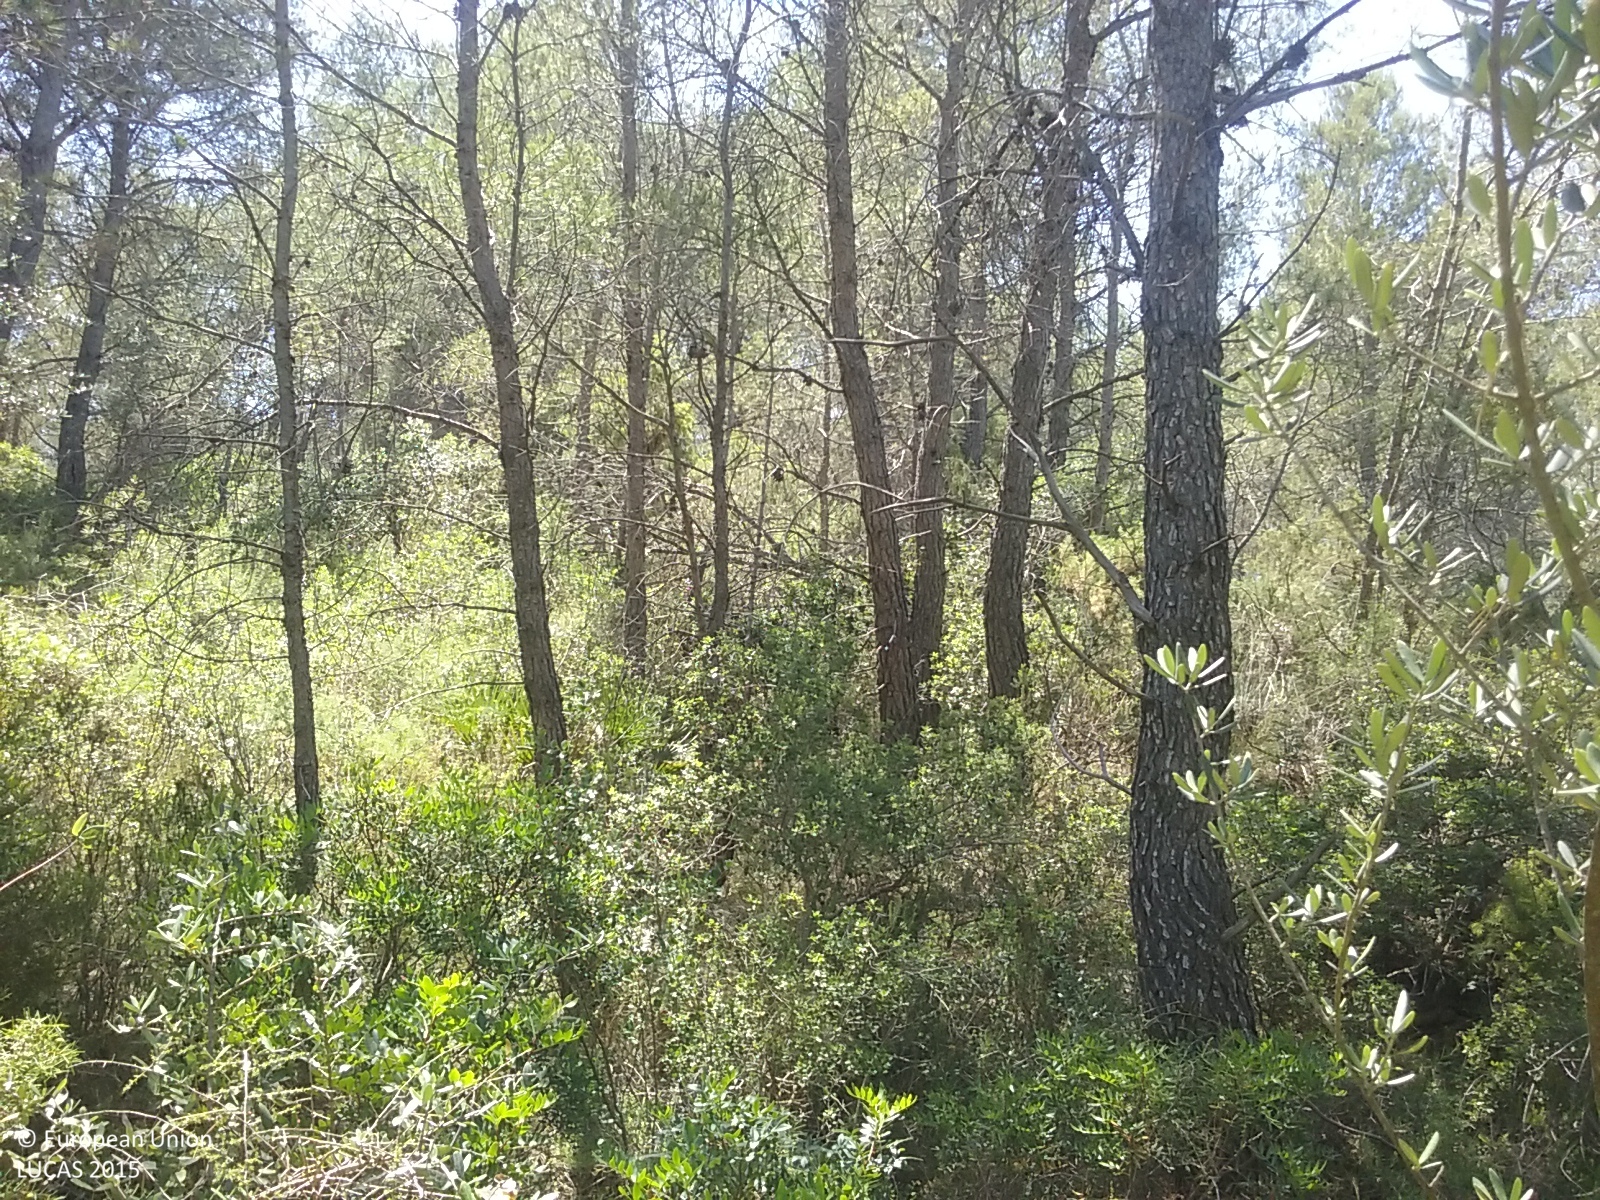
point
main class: Woodland
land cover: Pine dominated coniferous woodland
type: coniferous forest of the mediterranean region
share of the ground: > 75 %
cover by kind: coniferous forest trees 75 %, shrubs 20 %, herbaceous plants 5 %
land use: Semi-natural and natural areas not in use
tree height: > 5 m
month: June
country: ES
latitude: 40.9969
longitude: 0.5892
